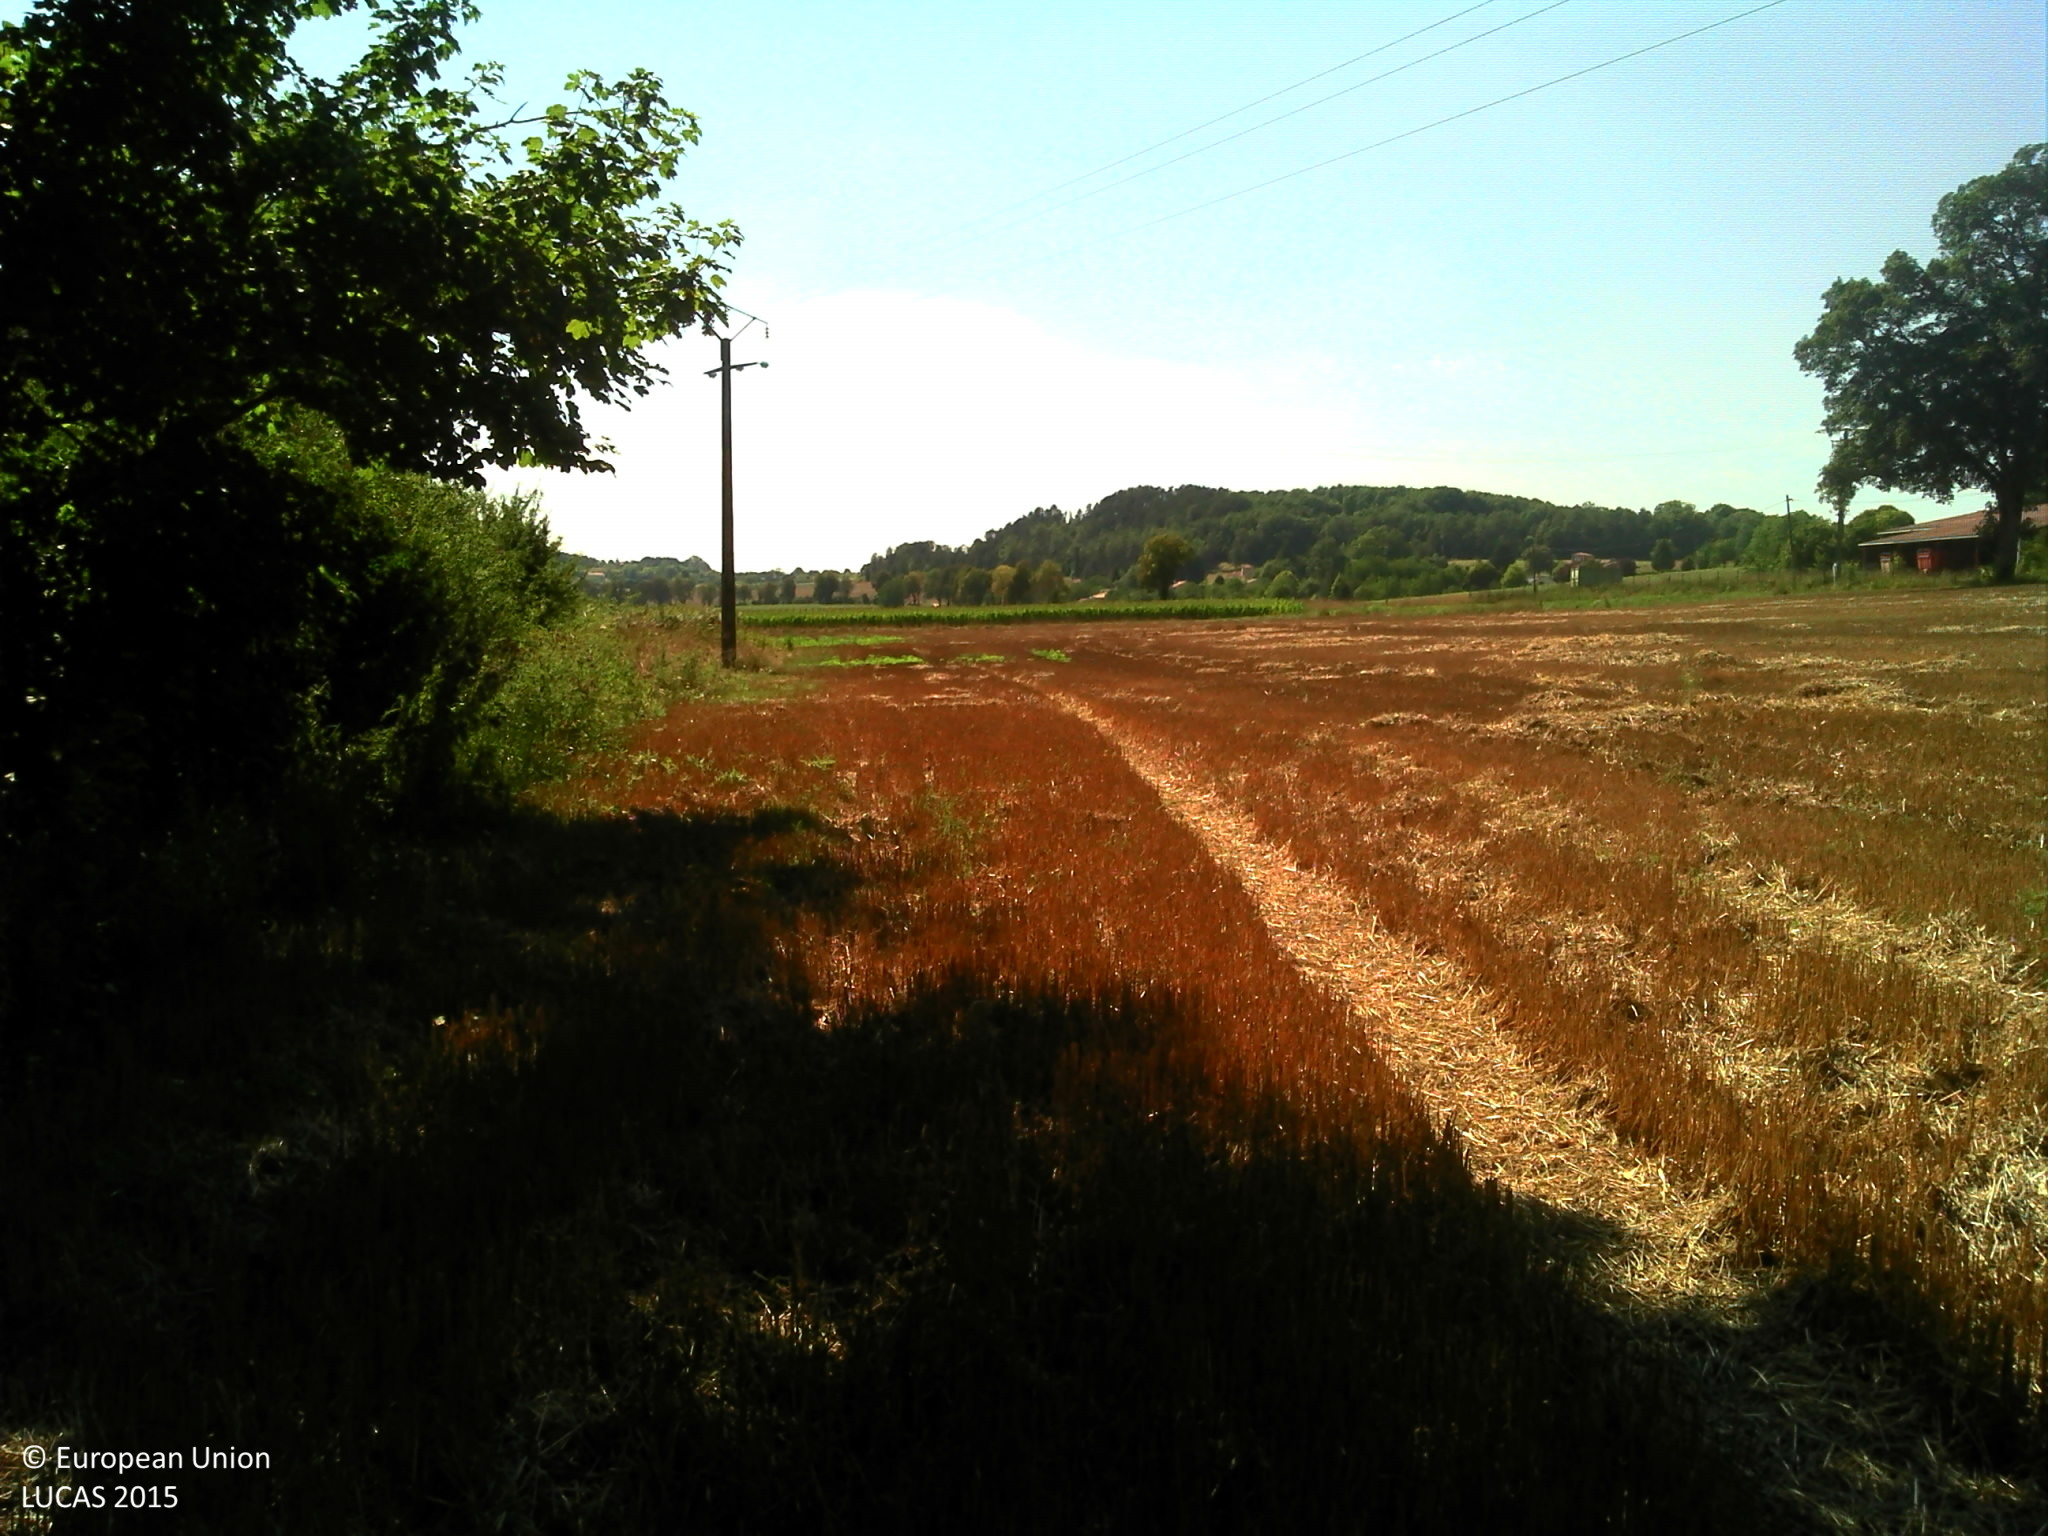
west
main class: Cropland
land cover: Common wheat
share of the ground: 10 - 25 %
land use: Agriculture (excluding fallow land and kitchen gardens)
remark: Harvested field
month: August
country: FR
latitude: 45.2988
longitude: 0.7700
